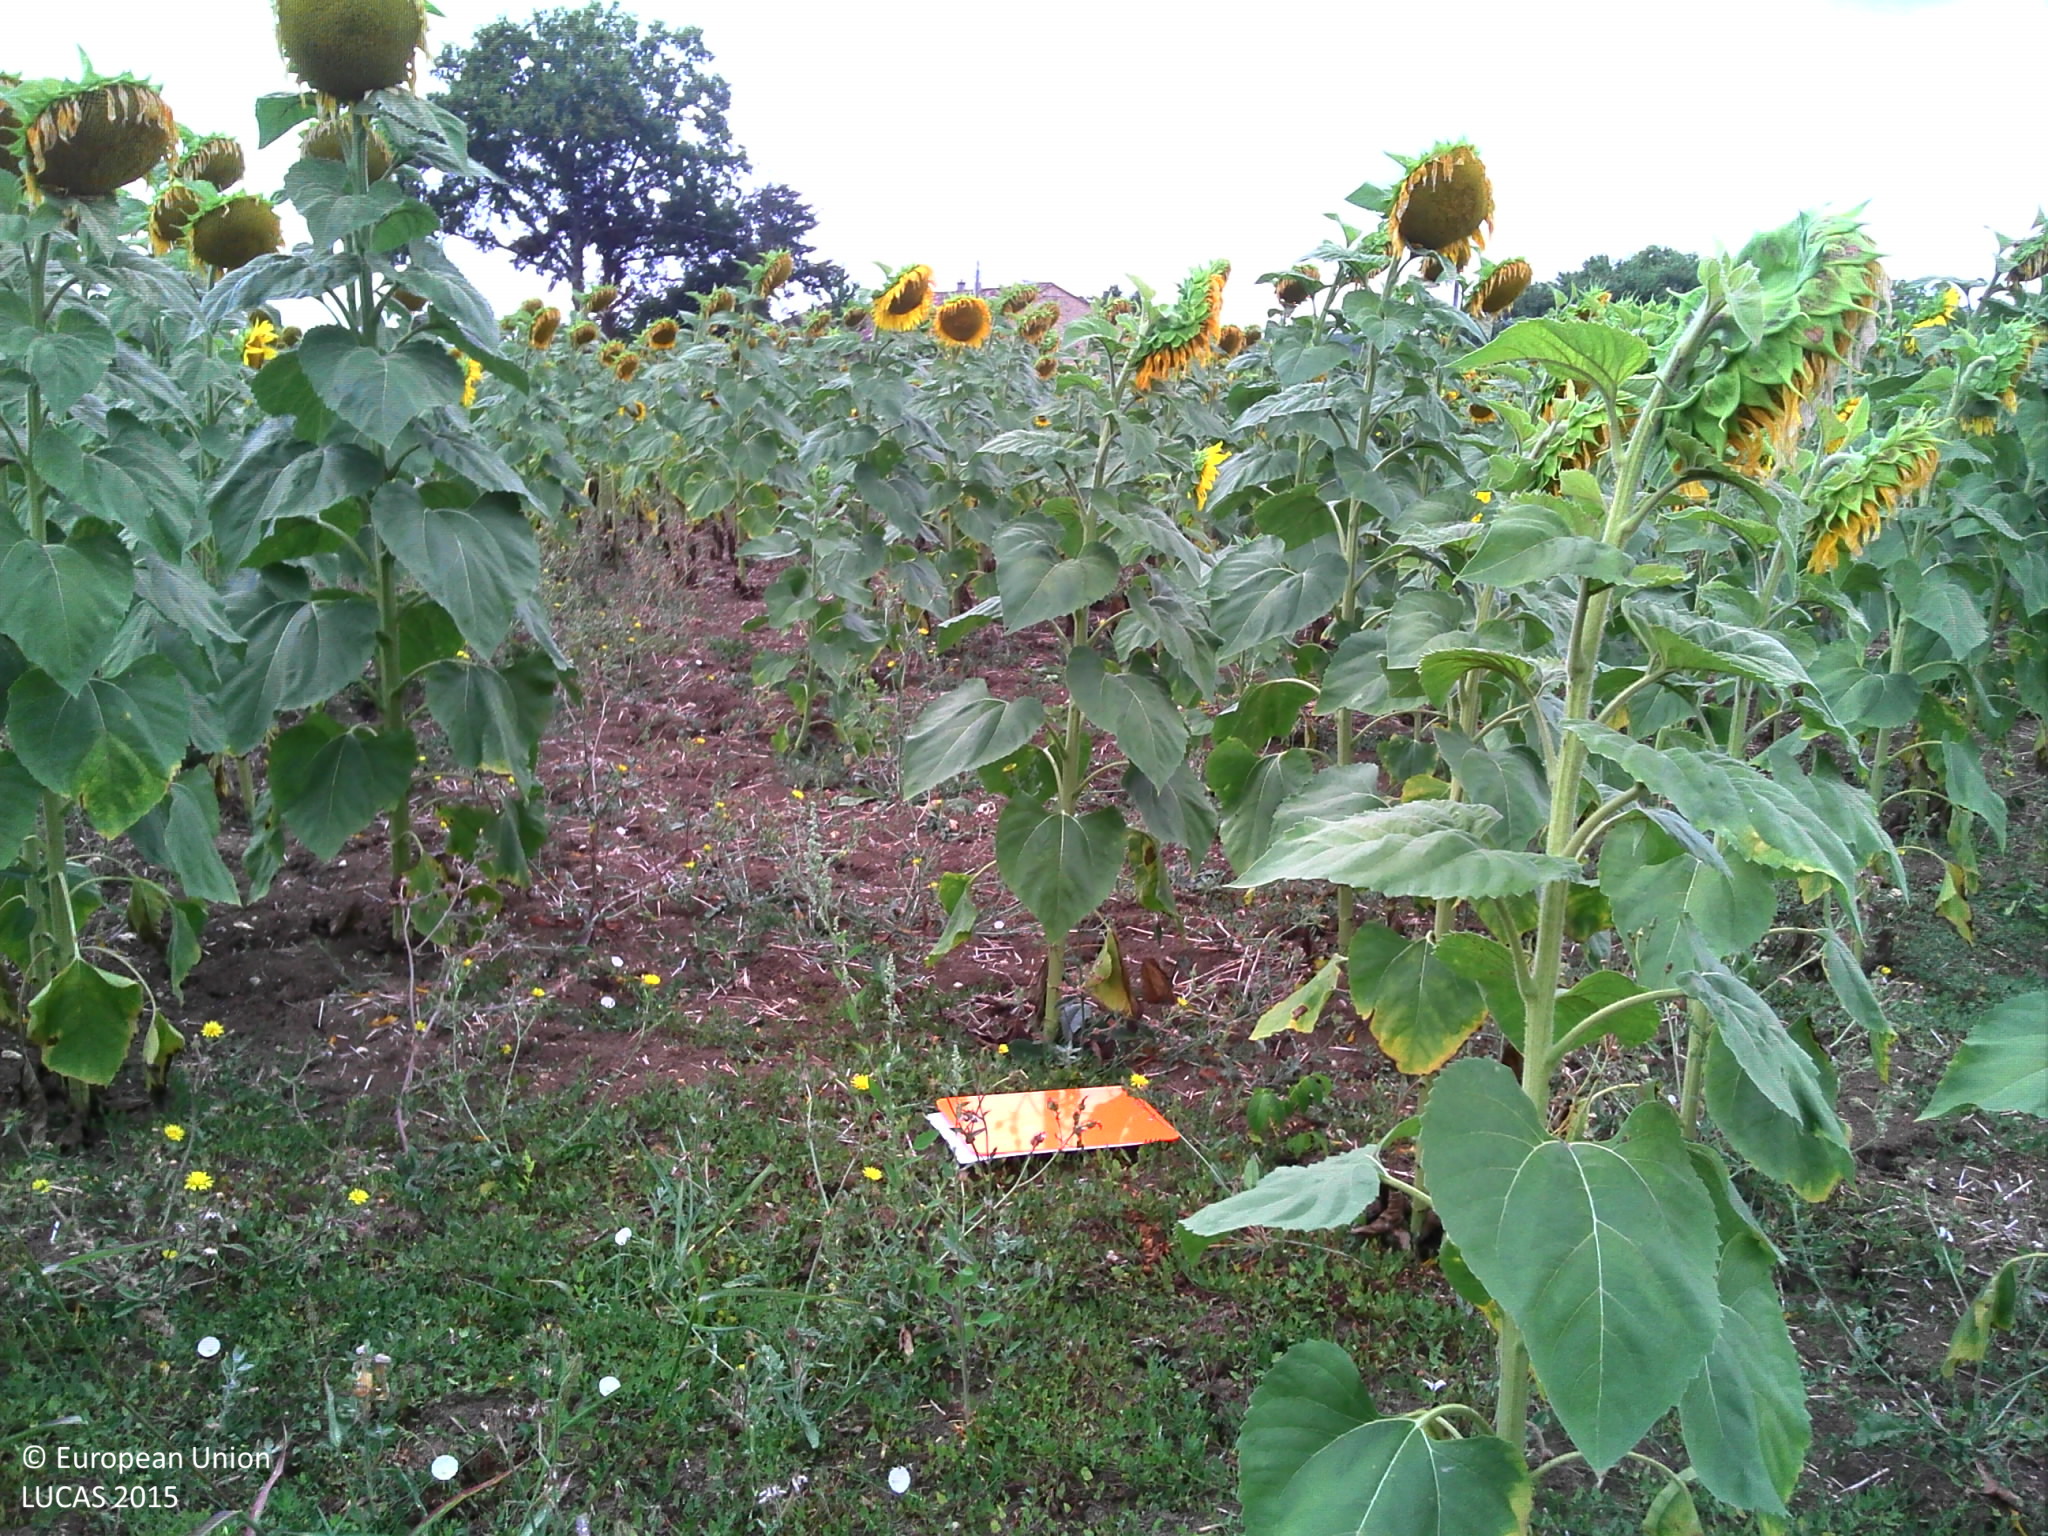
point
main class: Cropland
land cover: Sunflower
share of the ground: 50 - 75 %
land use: Agriculture (excluding fallow land and kitchen gardens)
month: August
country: FR
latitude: 44.6911
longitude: 0.8706
